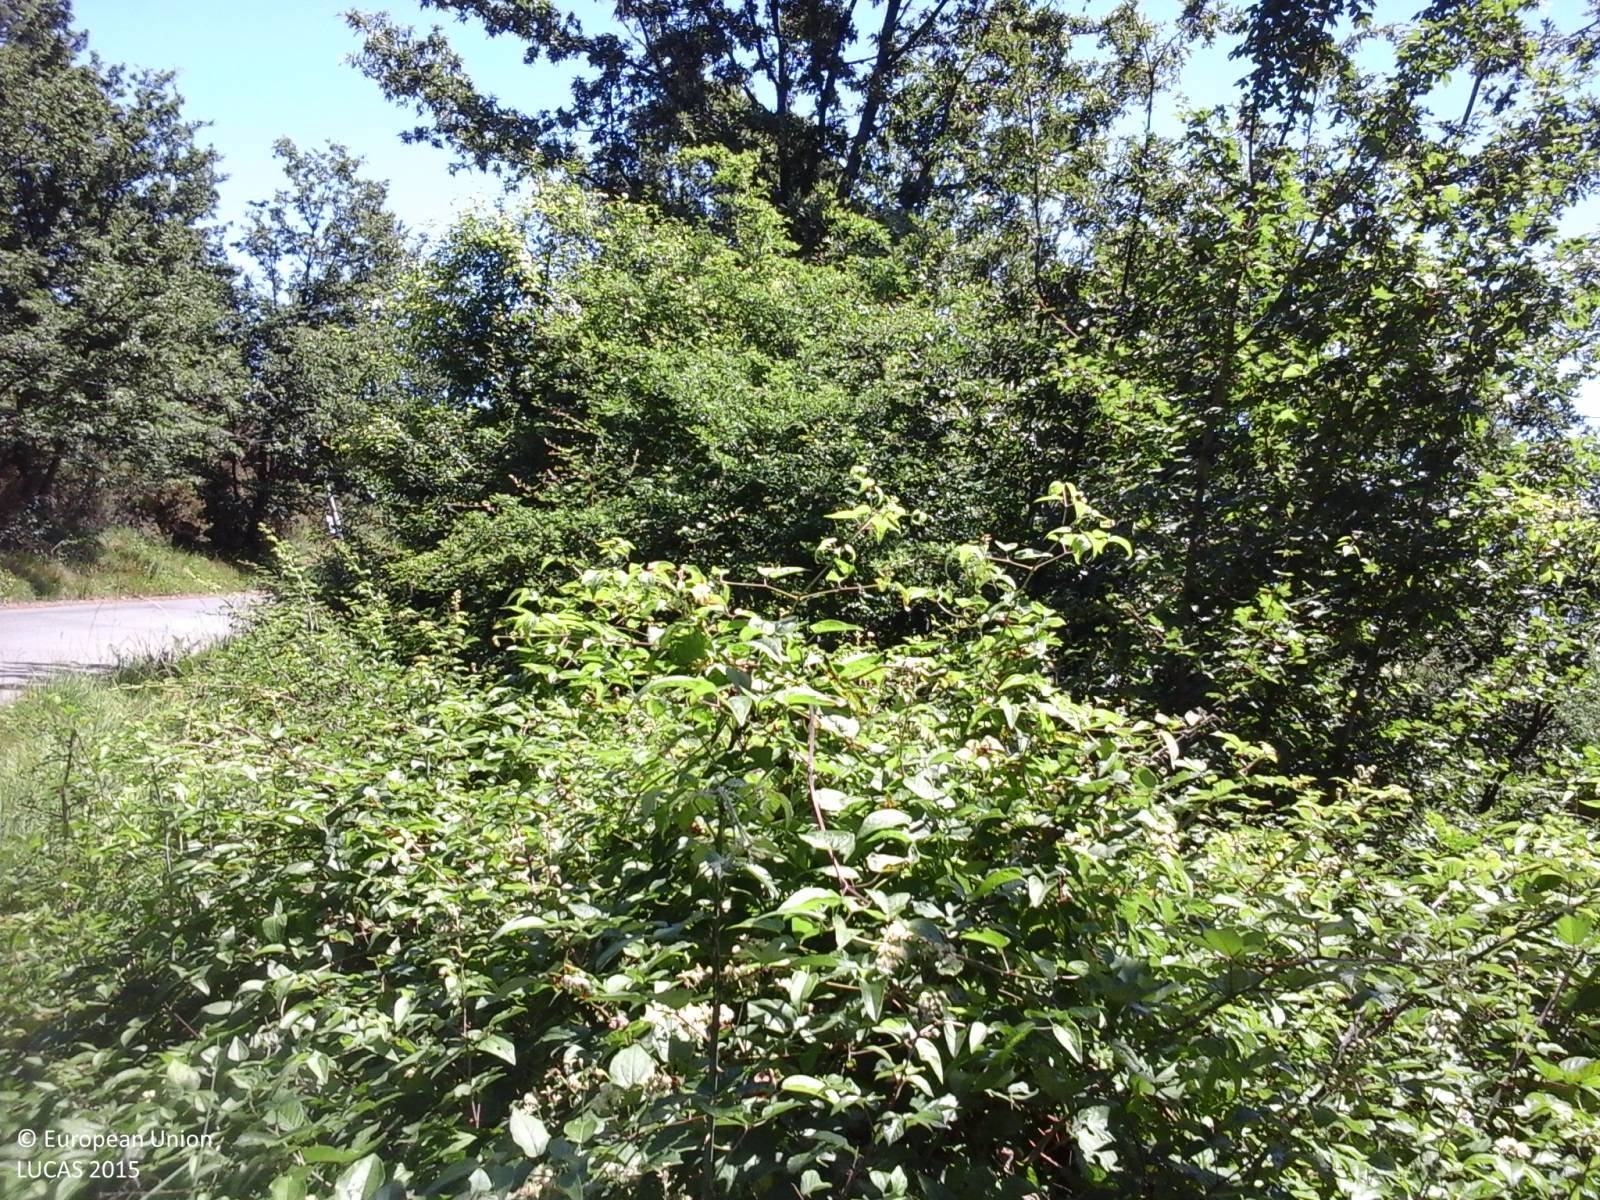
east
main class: Woodland
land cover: Broadleaved woodland
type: thermophilous deciduous forest
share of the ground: > 75 %
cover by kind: broadleaved forest trees 80 %, coniferous forest trees 10 %, shrubs 10 %
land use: Semi-natural and natural areas not in use
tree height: > 5 m
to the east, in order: Broadleaved woodland
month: June
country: IT
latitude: 44.2062
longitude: 9.9126
